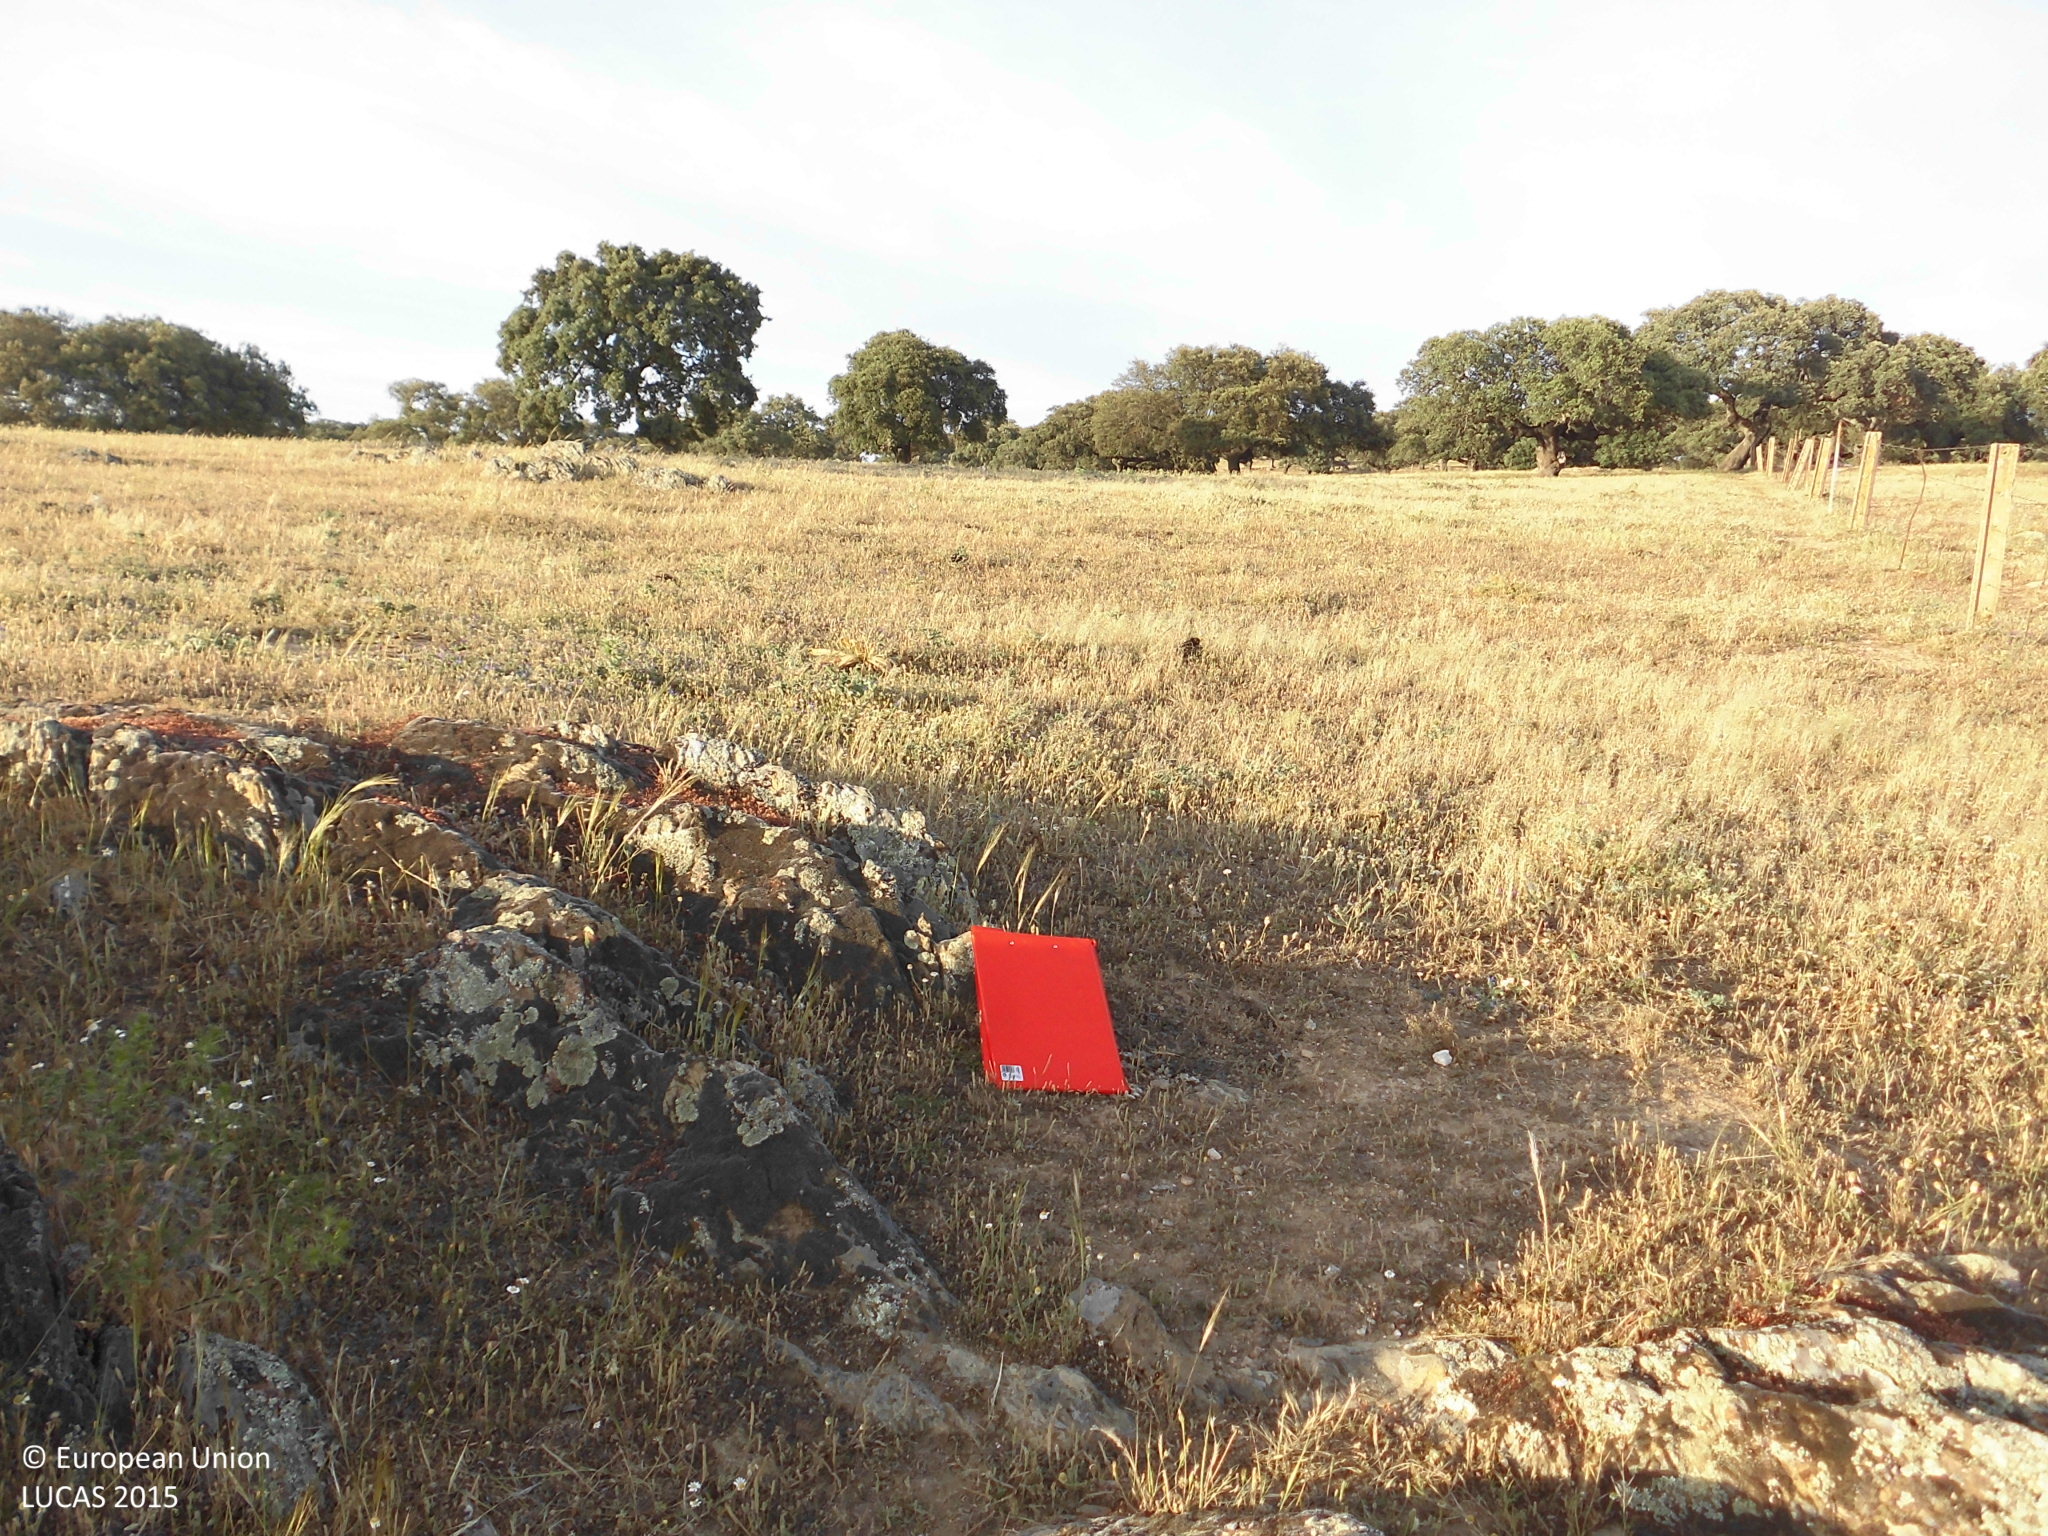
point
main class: Grassland
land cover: Grassland without tree/shrub cover
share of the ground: > 75 %
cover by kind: herbaceous plants 100 %
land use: Agriculture (excluding fallow land and kitchen gardens)
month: May
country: ES
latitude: 39.5907
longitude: -6.0984
